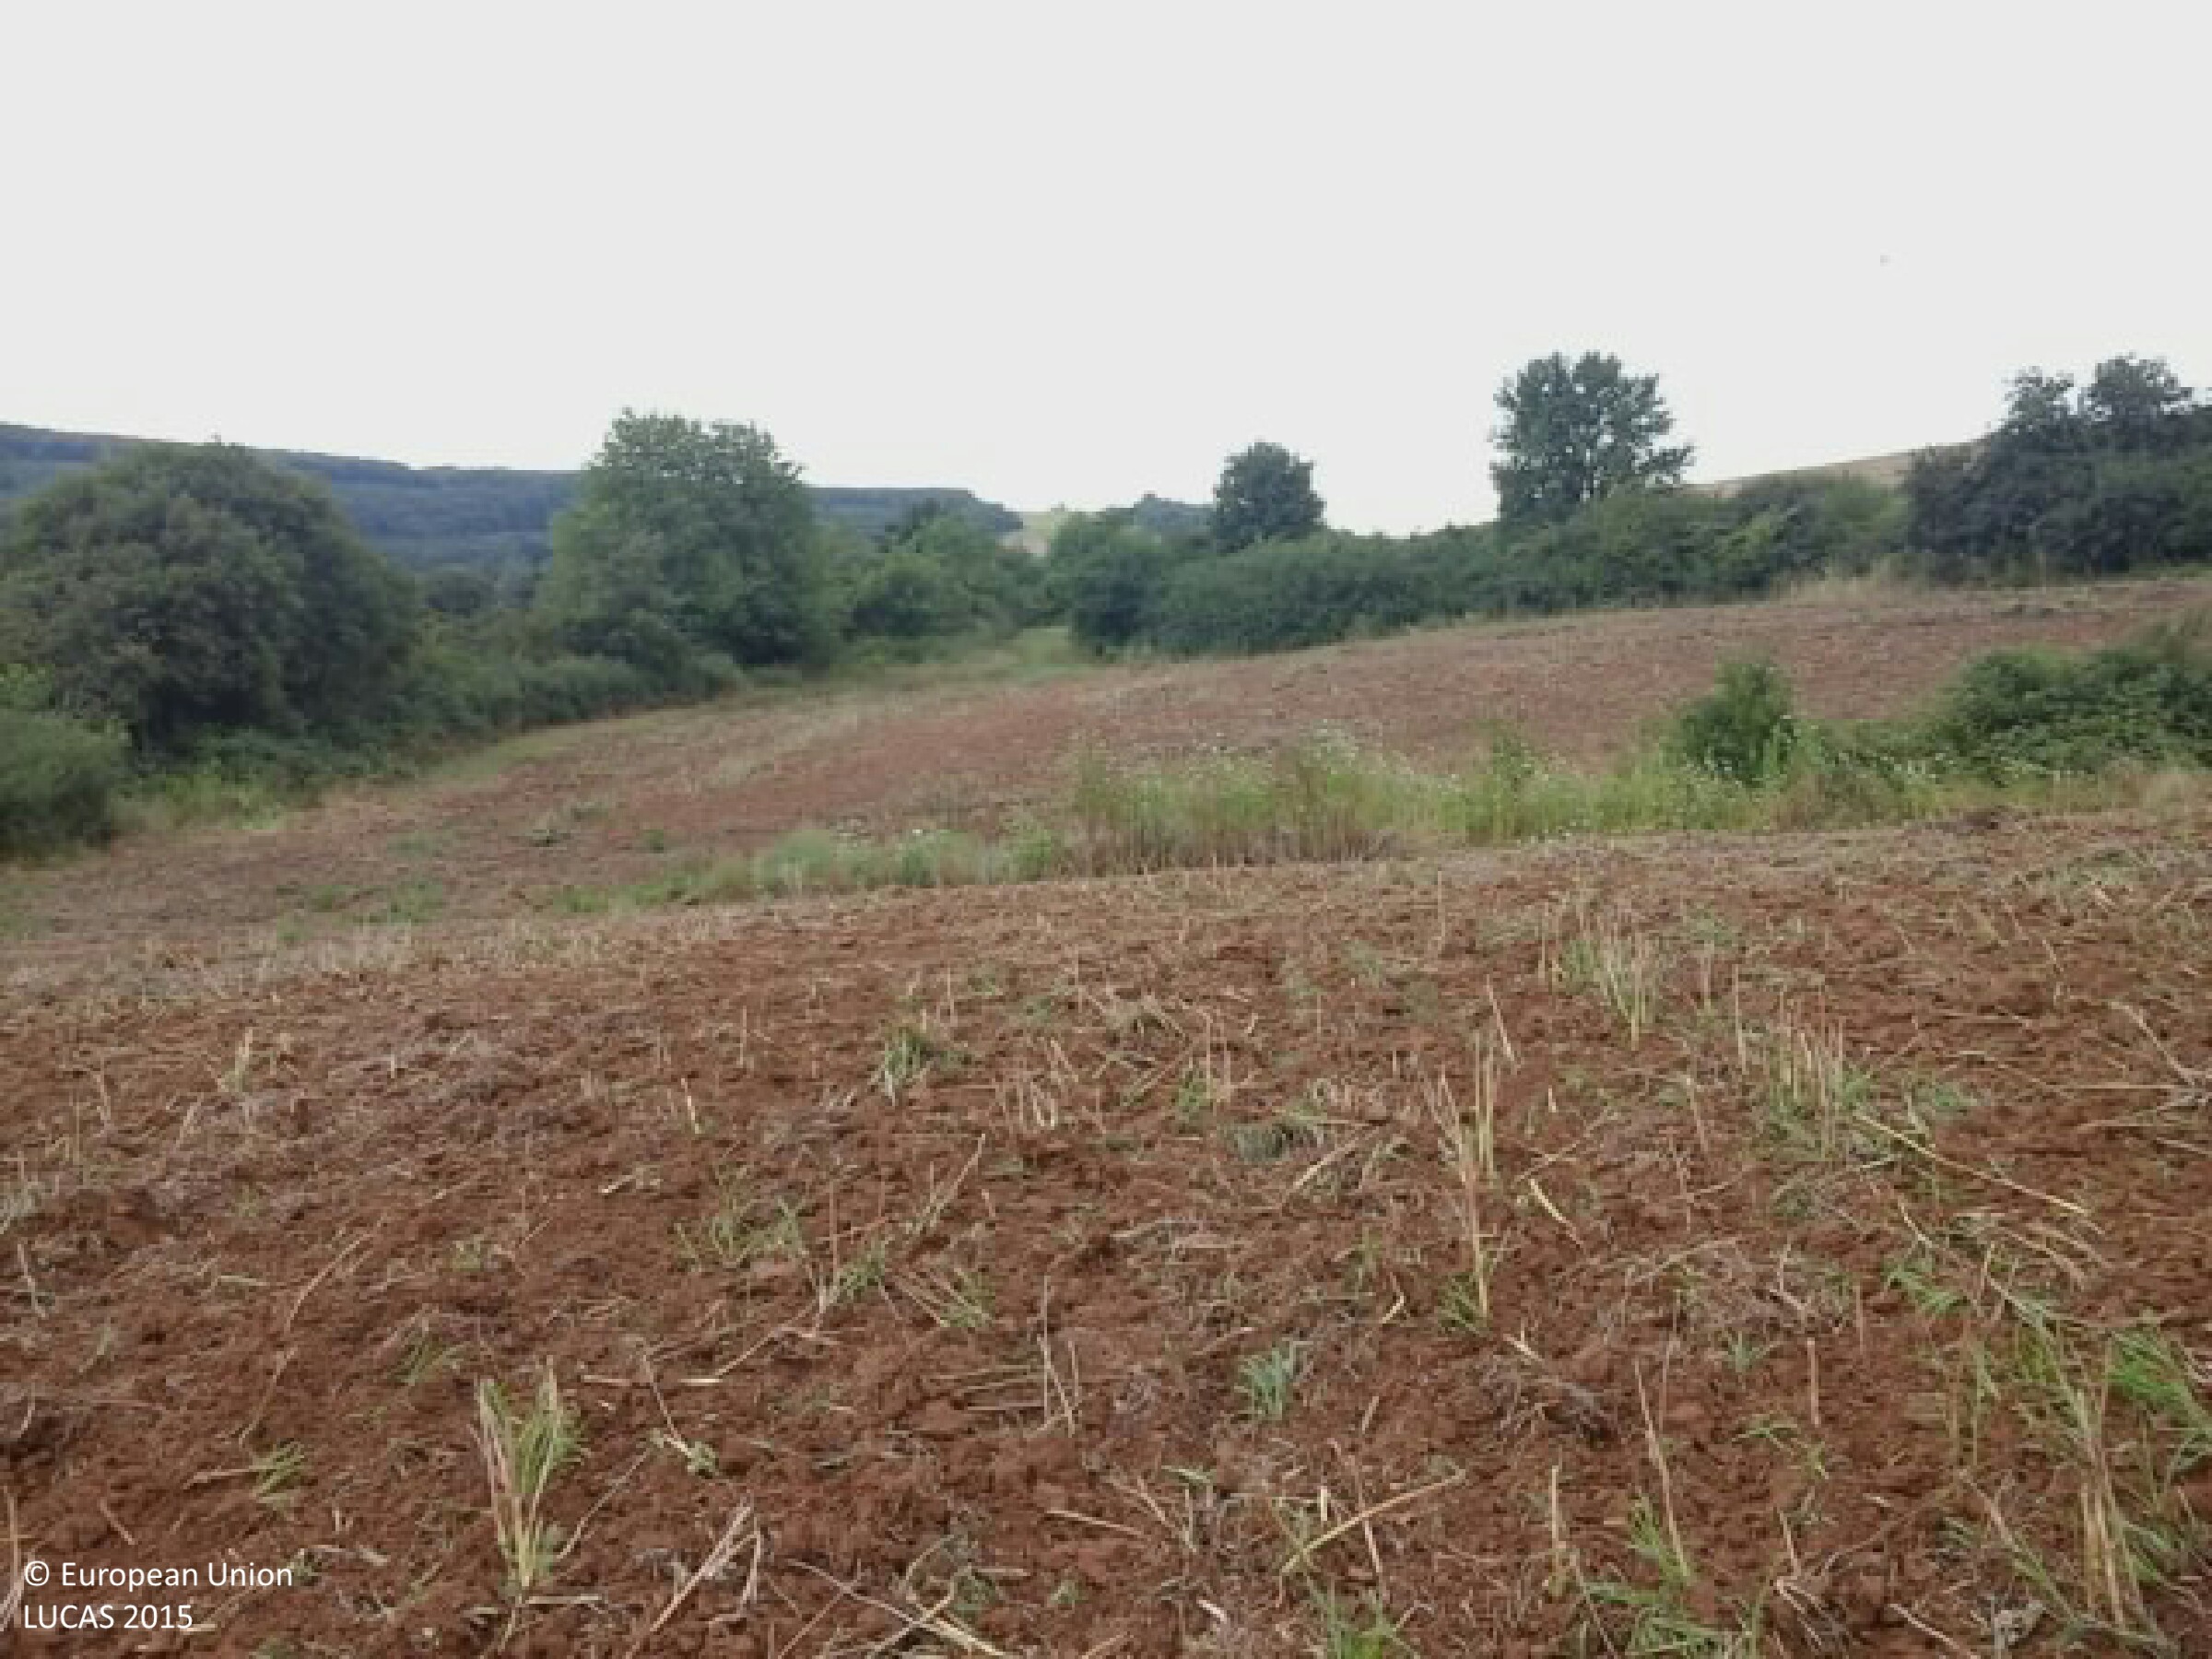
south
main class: Cropland
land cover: Rape and turnip rape
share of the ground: > 75 %
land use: Agriculture (excluding fallow land and kitchen gardens)
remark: Harvested field
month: July
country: HU
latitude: 46.2534
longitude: 17.9580
